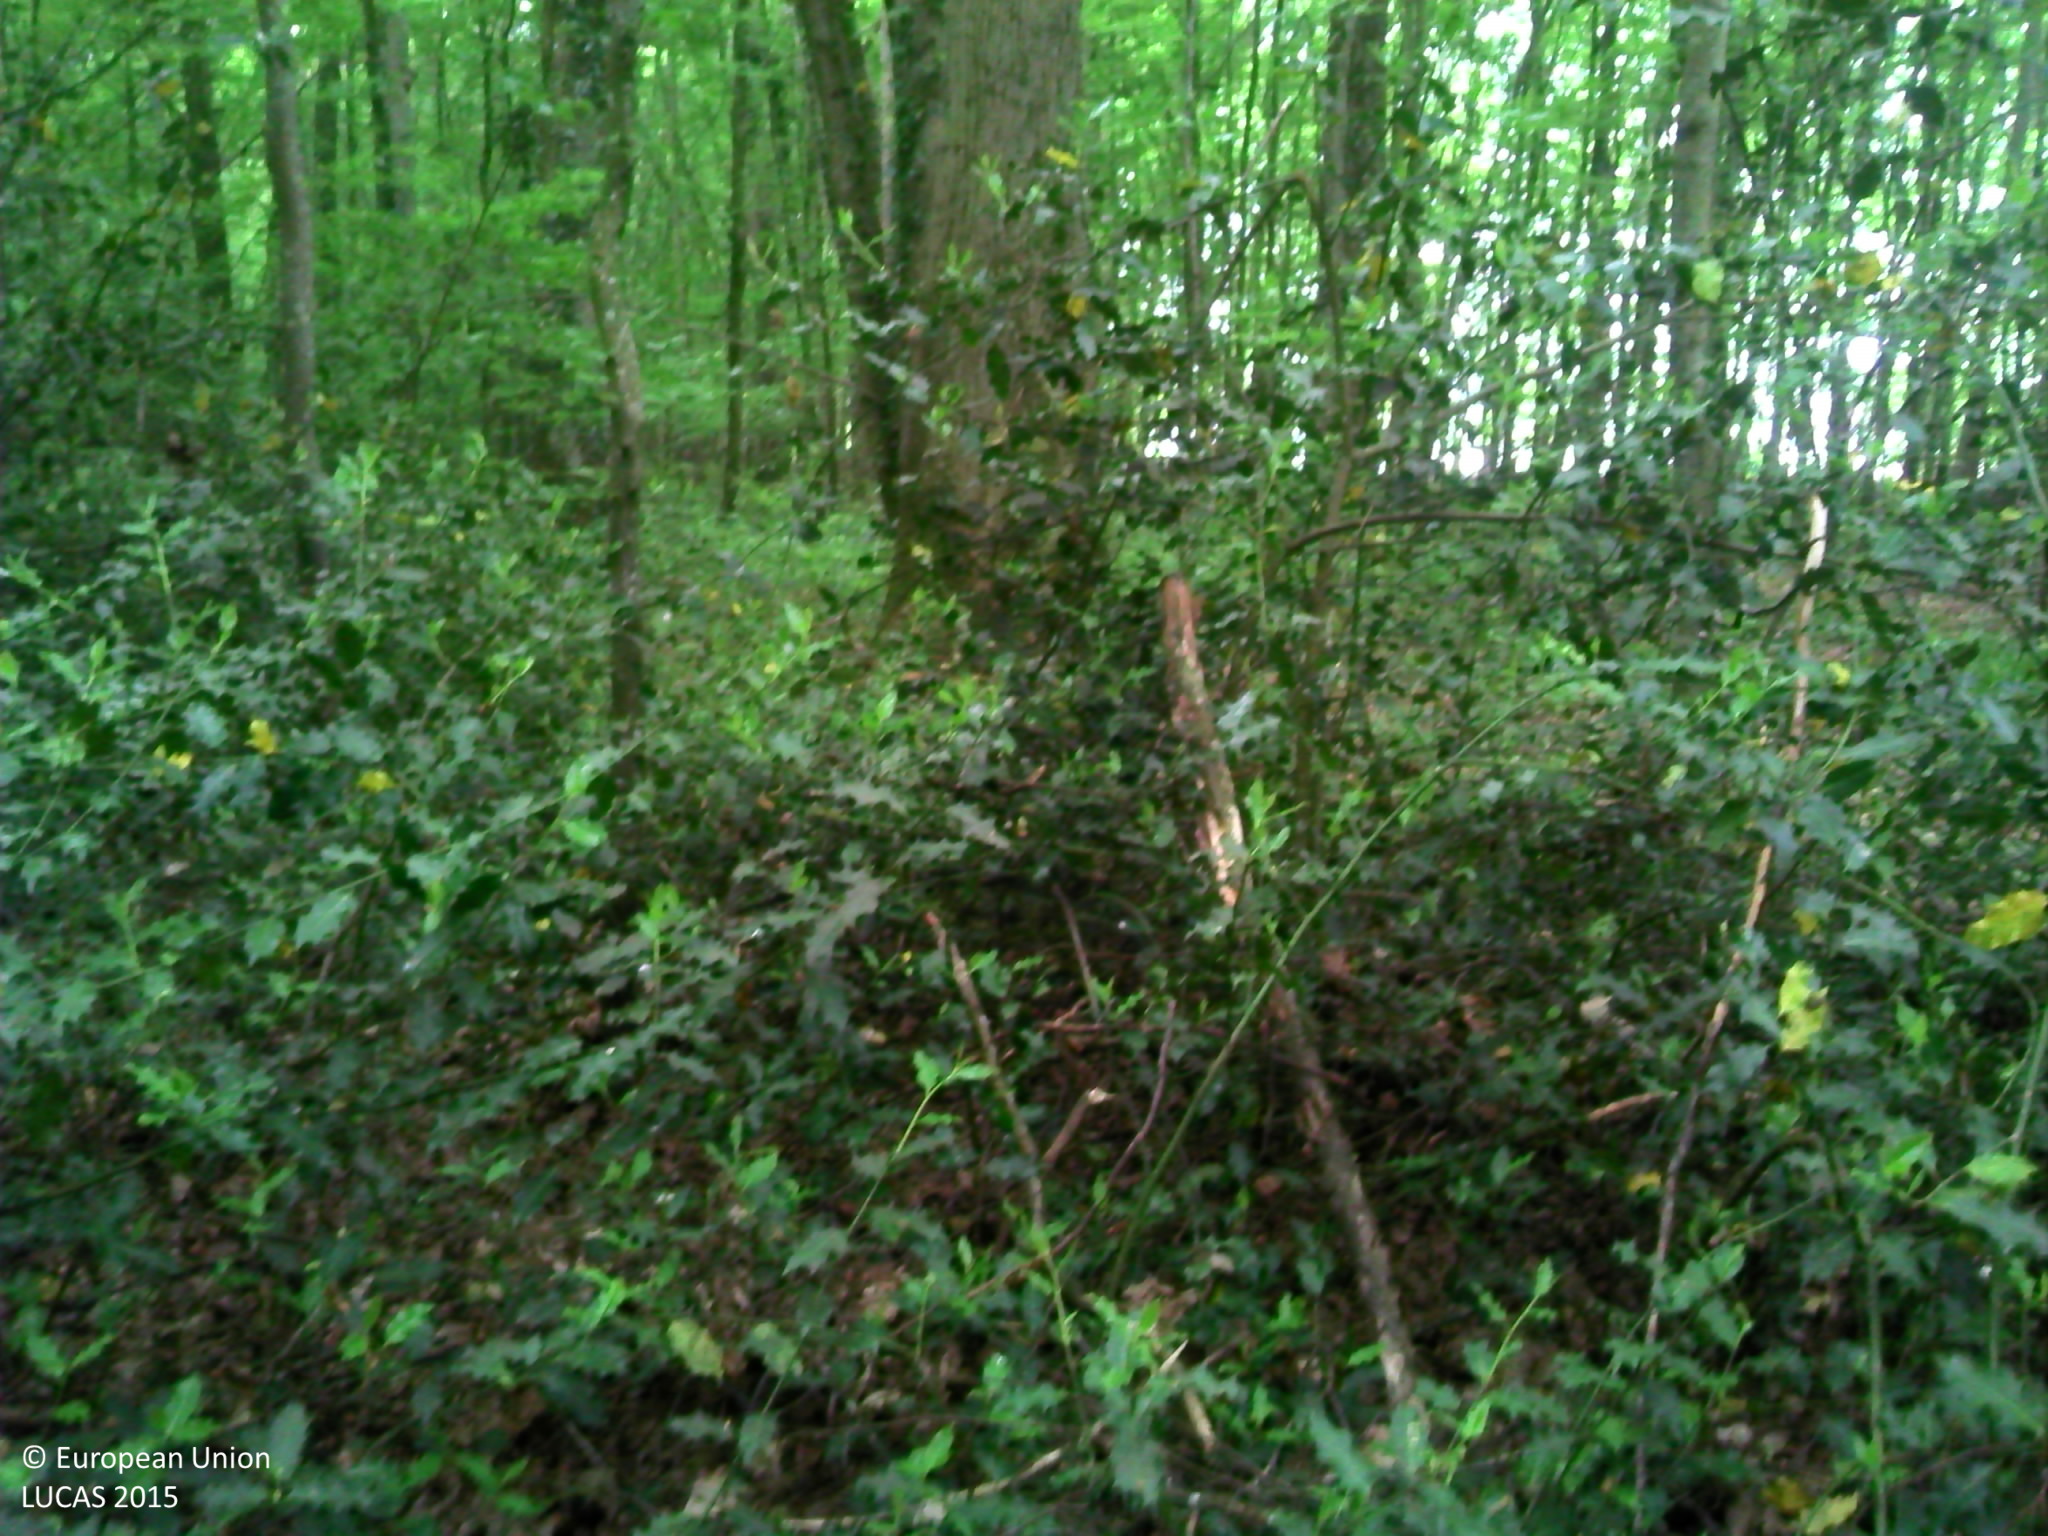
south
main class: Woodland
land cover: Broadleaved woodland
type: mesophytic deciduous forest
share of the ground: > 75 %
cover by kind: broadleaved forest trees 90 %, herbaceous plants 10 %
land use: Forestry
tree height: > 5 m
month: May
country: FR
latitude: 48.5867
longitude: 4.7784
